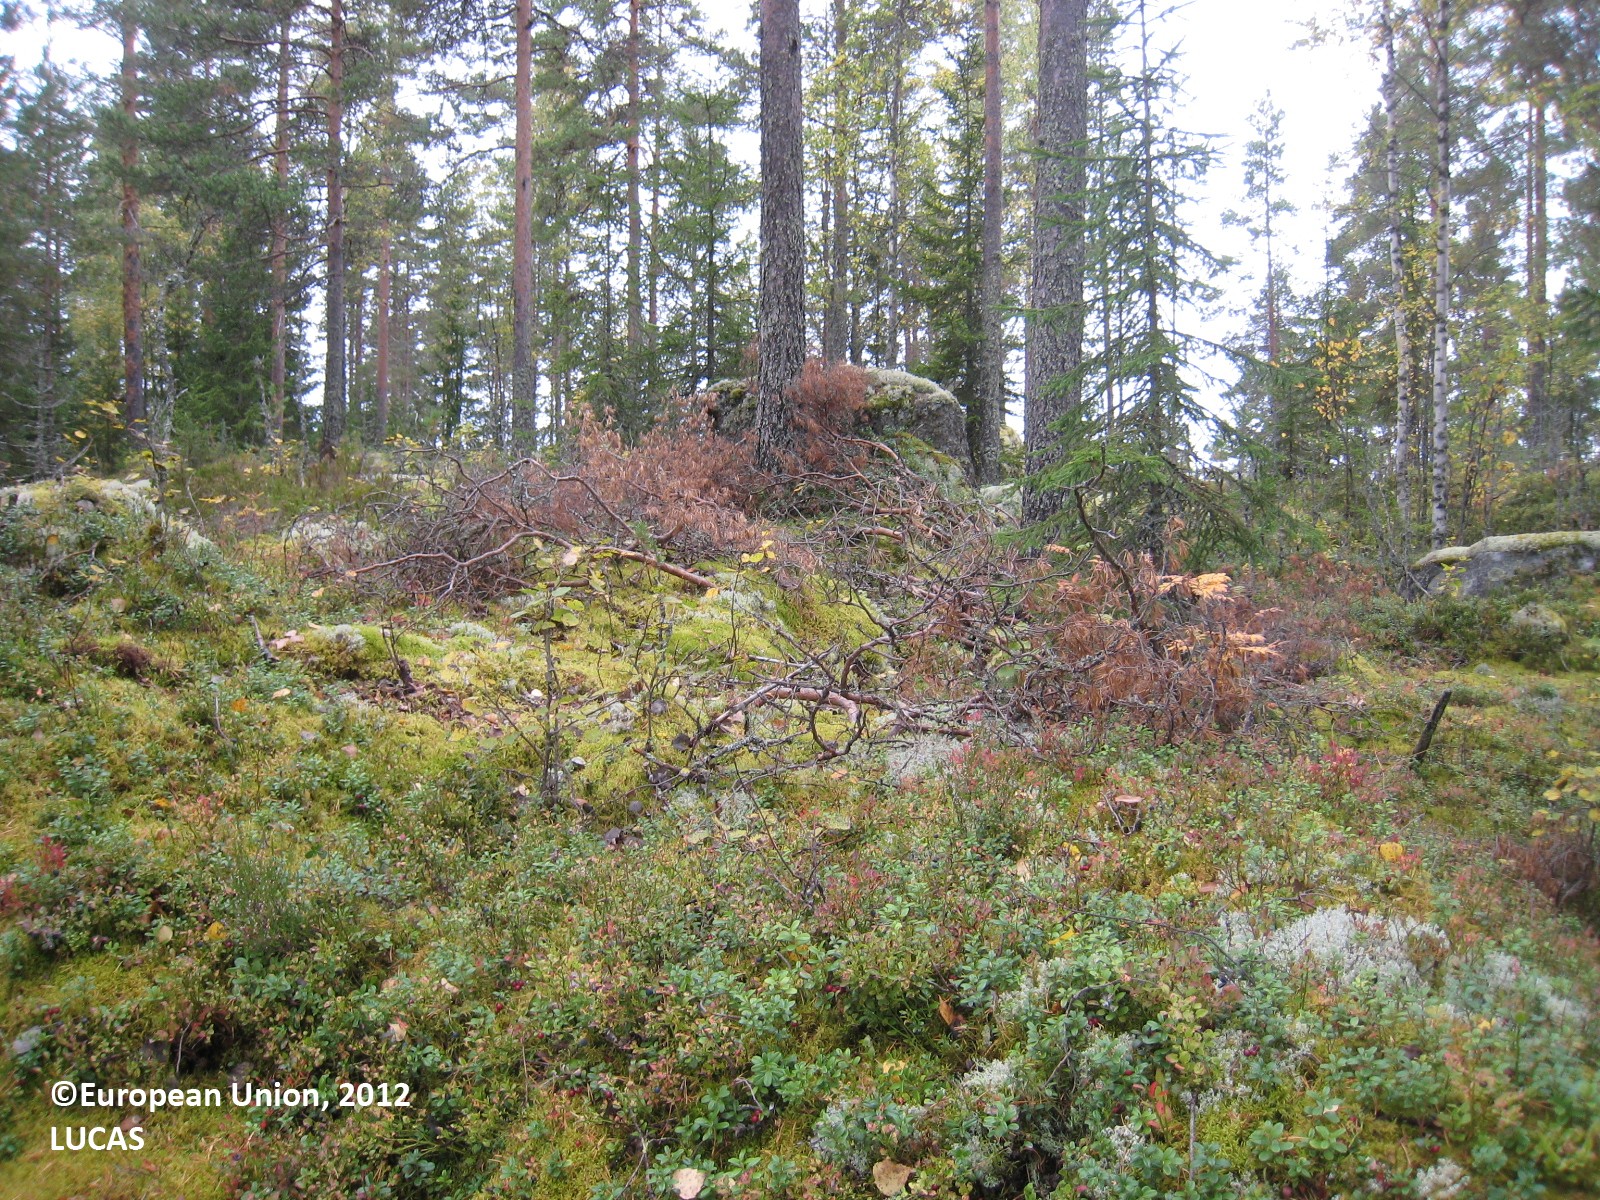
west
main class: Woodland
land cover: Other coniferous woodland
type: boreal forest
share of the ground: 50 - 75 %
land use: Forestry
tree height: > 5 m
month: September
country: FI
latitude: 62.5363
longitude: 26.5625
